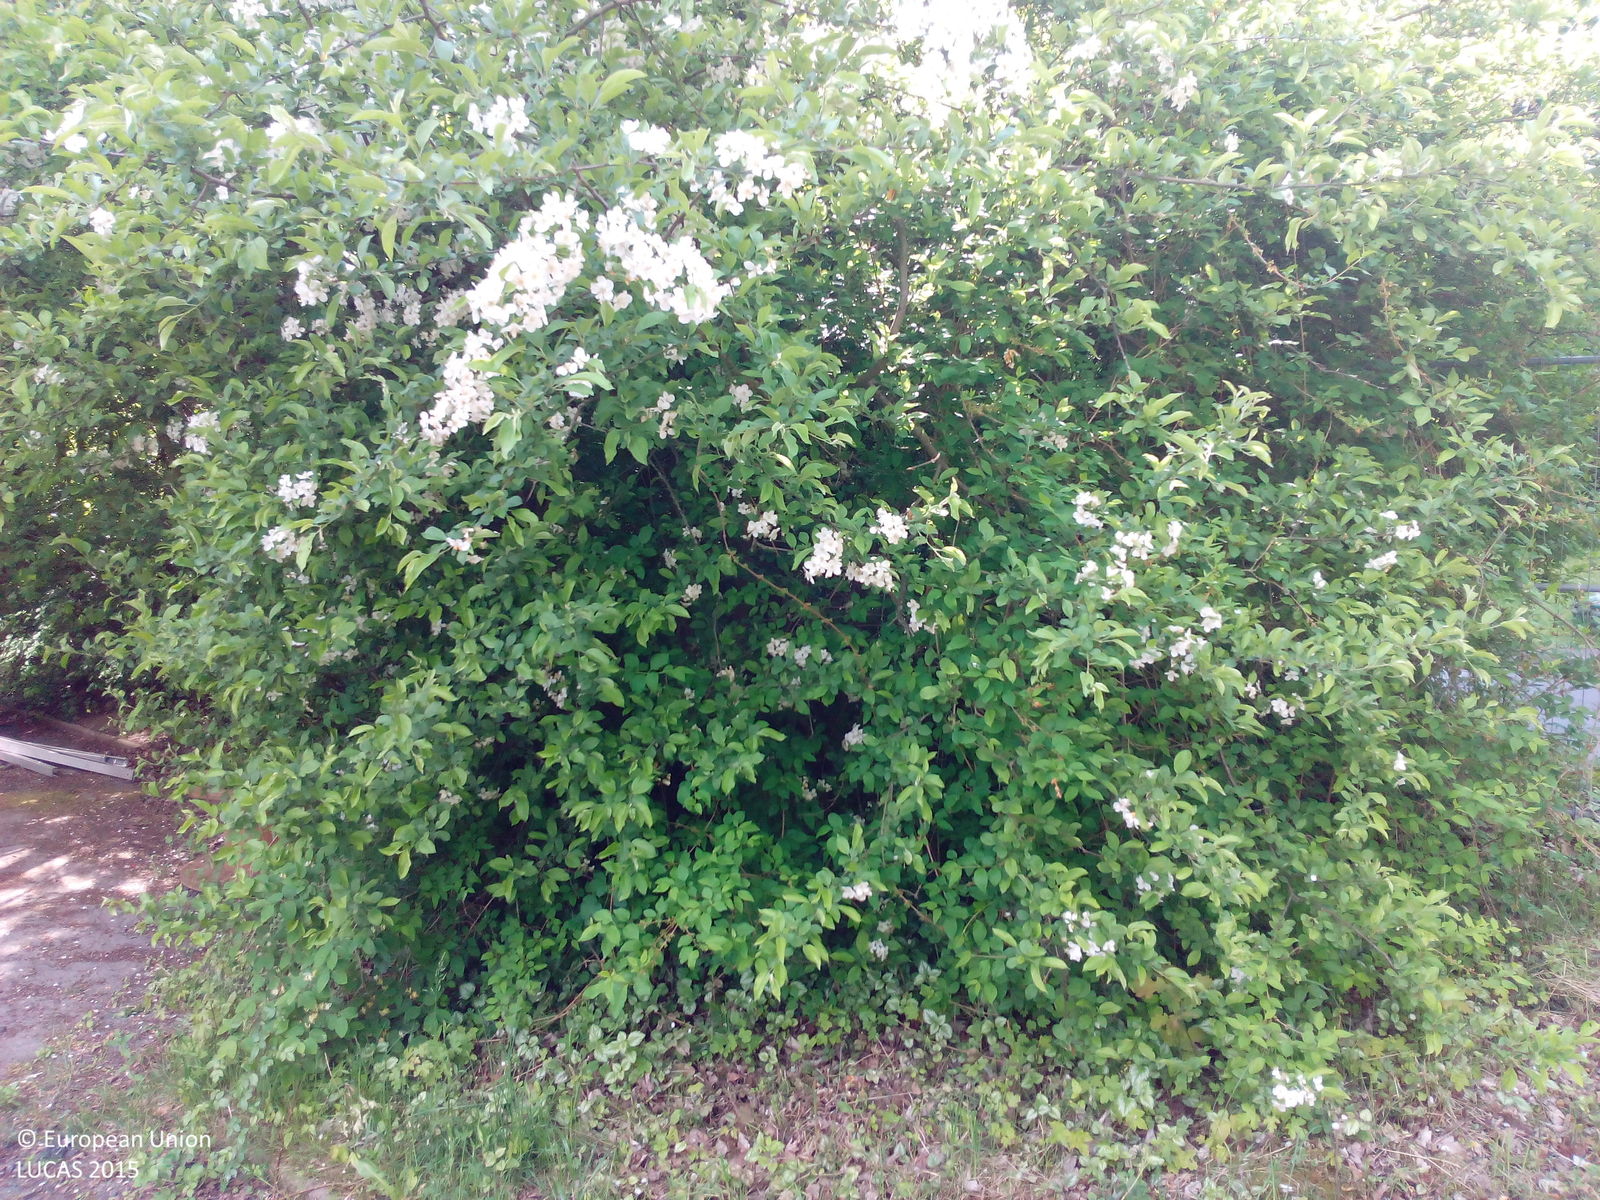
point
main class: Shrubland
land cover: Shrubland without tree cover
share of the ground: > 75 %
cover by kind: shrubs 100 %
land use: Road transport
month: May
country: DE
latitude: 51.8736
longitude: 9.6370
